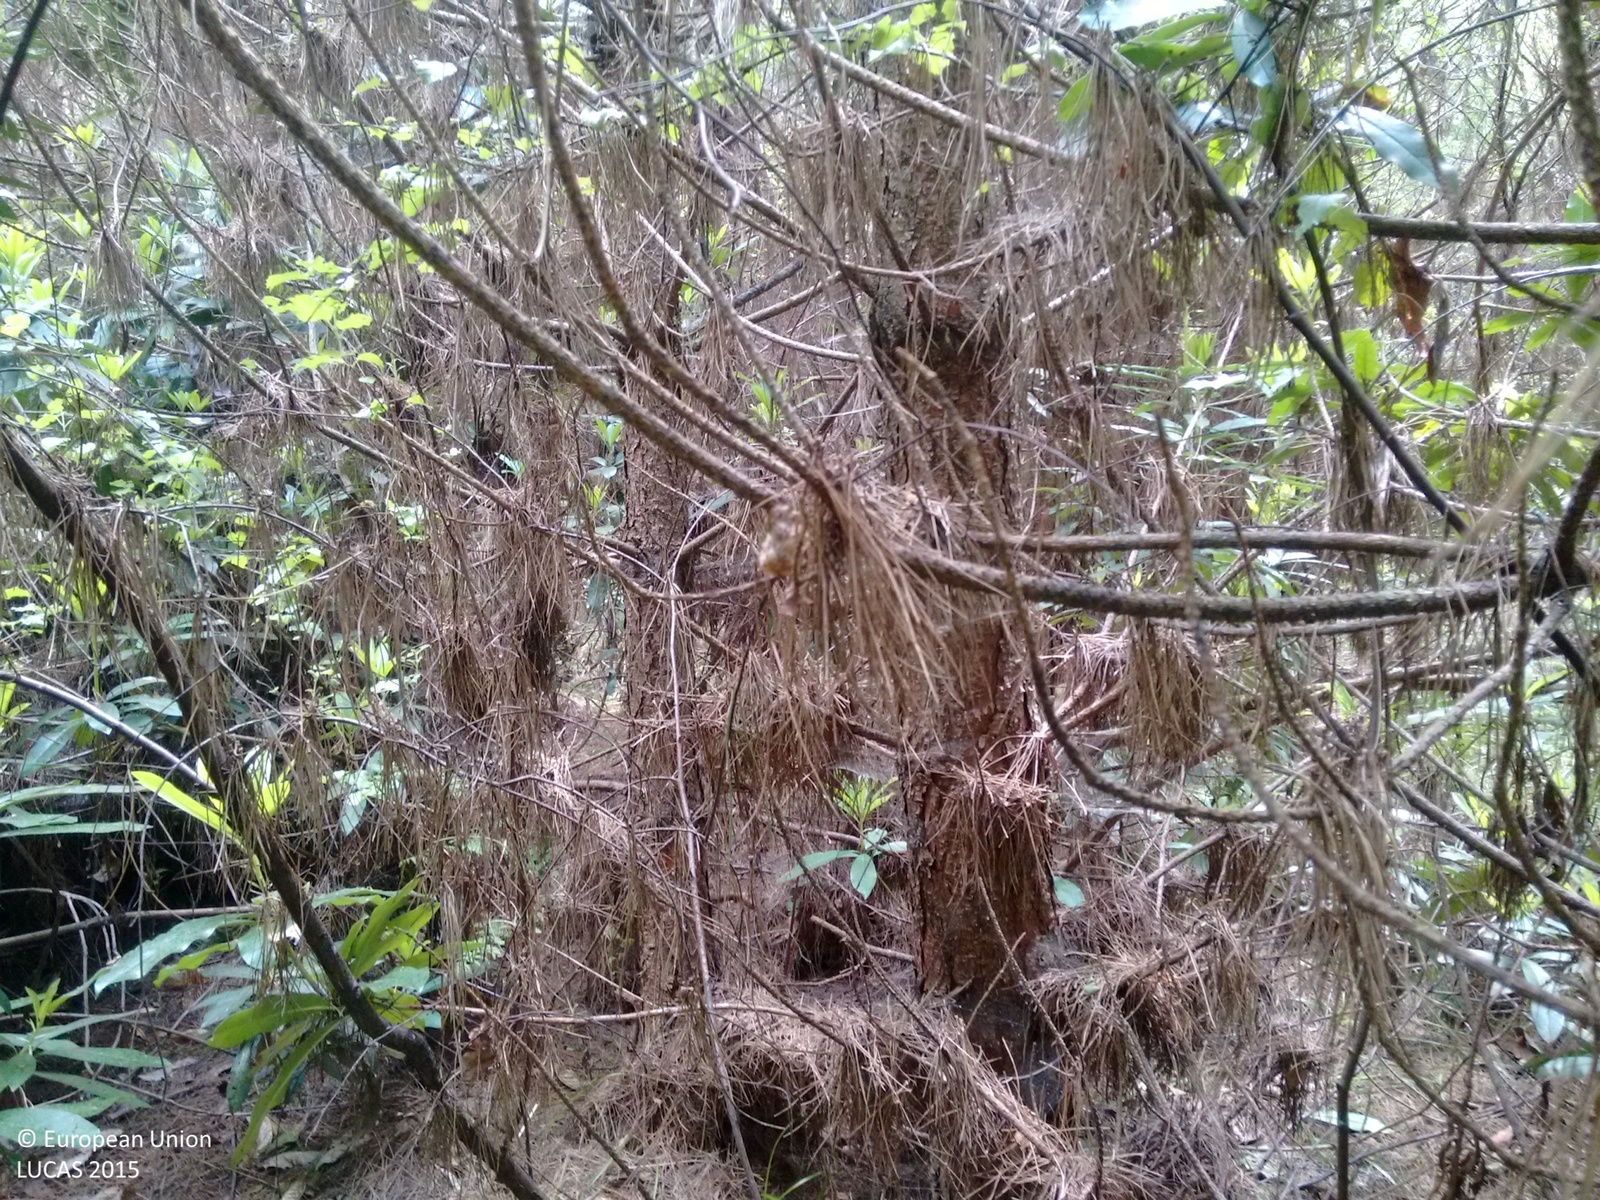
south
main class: Woodland
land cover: Pine dominated coniferous woodland
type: exotic forest
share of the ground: > 75 %
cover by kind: coniferous forest trees 95 %, shrubs 5 %
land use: Forestry
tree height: > 5 m
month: June
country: GB
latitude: 51.0979
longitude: 0.5911
